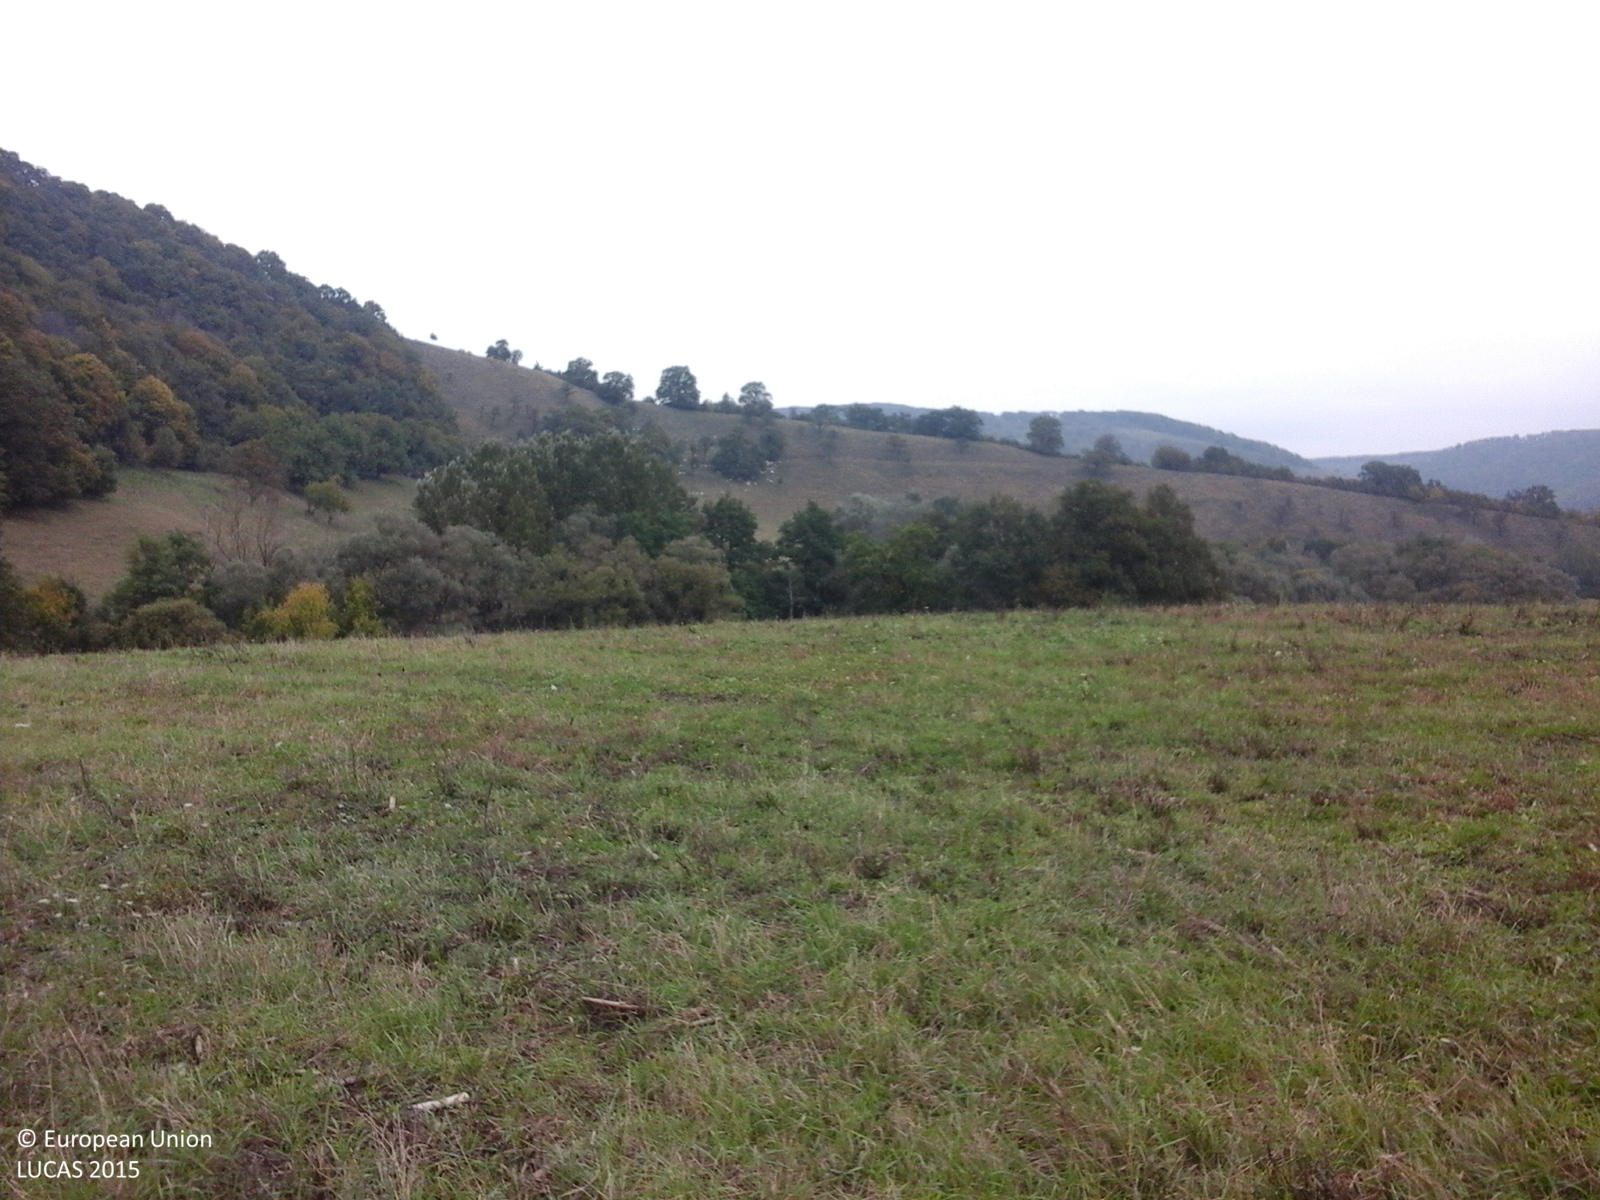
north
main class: Grassland
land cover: Grassland without tree/shrub cover
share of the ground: > 75 %
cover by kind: herbaceous plants 100 %
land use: Agriculture (excluding fallow land and kitchen gardens)
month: October
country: RO
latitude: 46.1433
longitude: 25.0219
